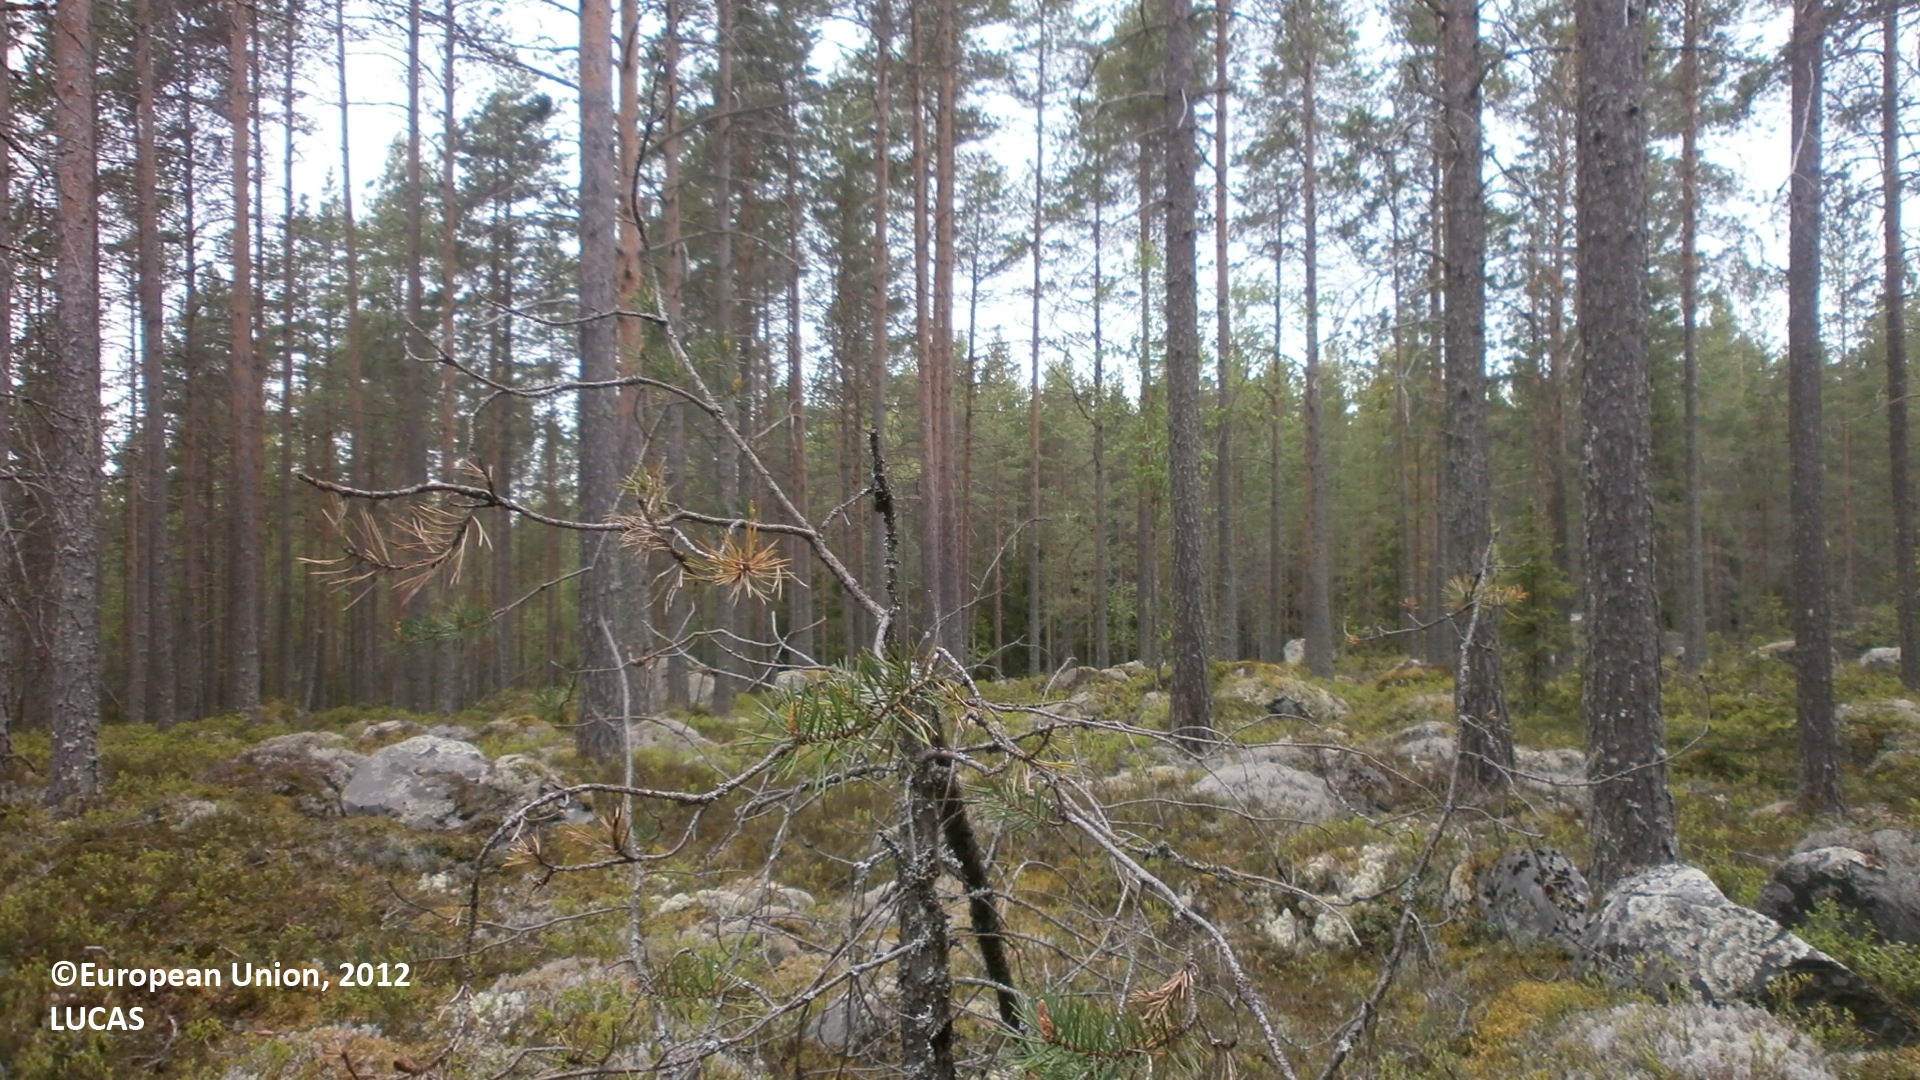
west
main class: Woodland
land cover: Pine dominated coniferous woodland
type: hemiboreal forest and nemoral coniferous forest and mixed broadleaved-coniferous forest
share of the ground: 25 - 50 %
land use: Forestry
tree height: > 5 m
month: June
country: FI
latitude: 64.4410
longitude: 25.1437
